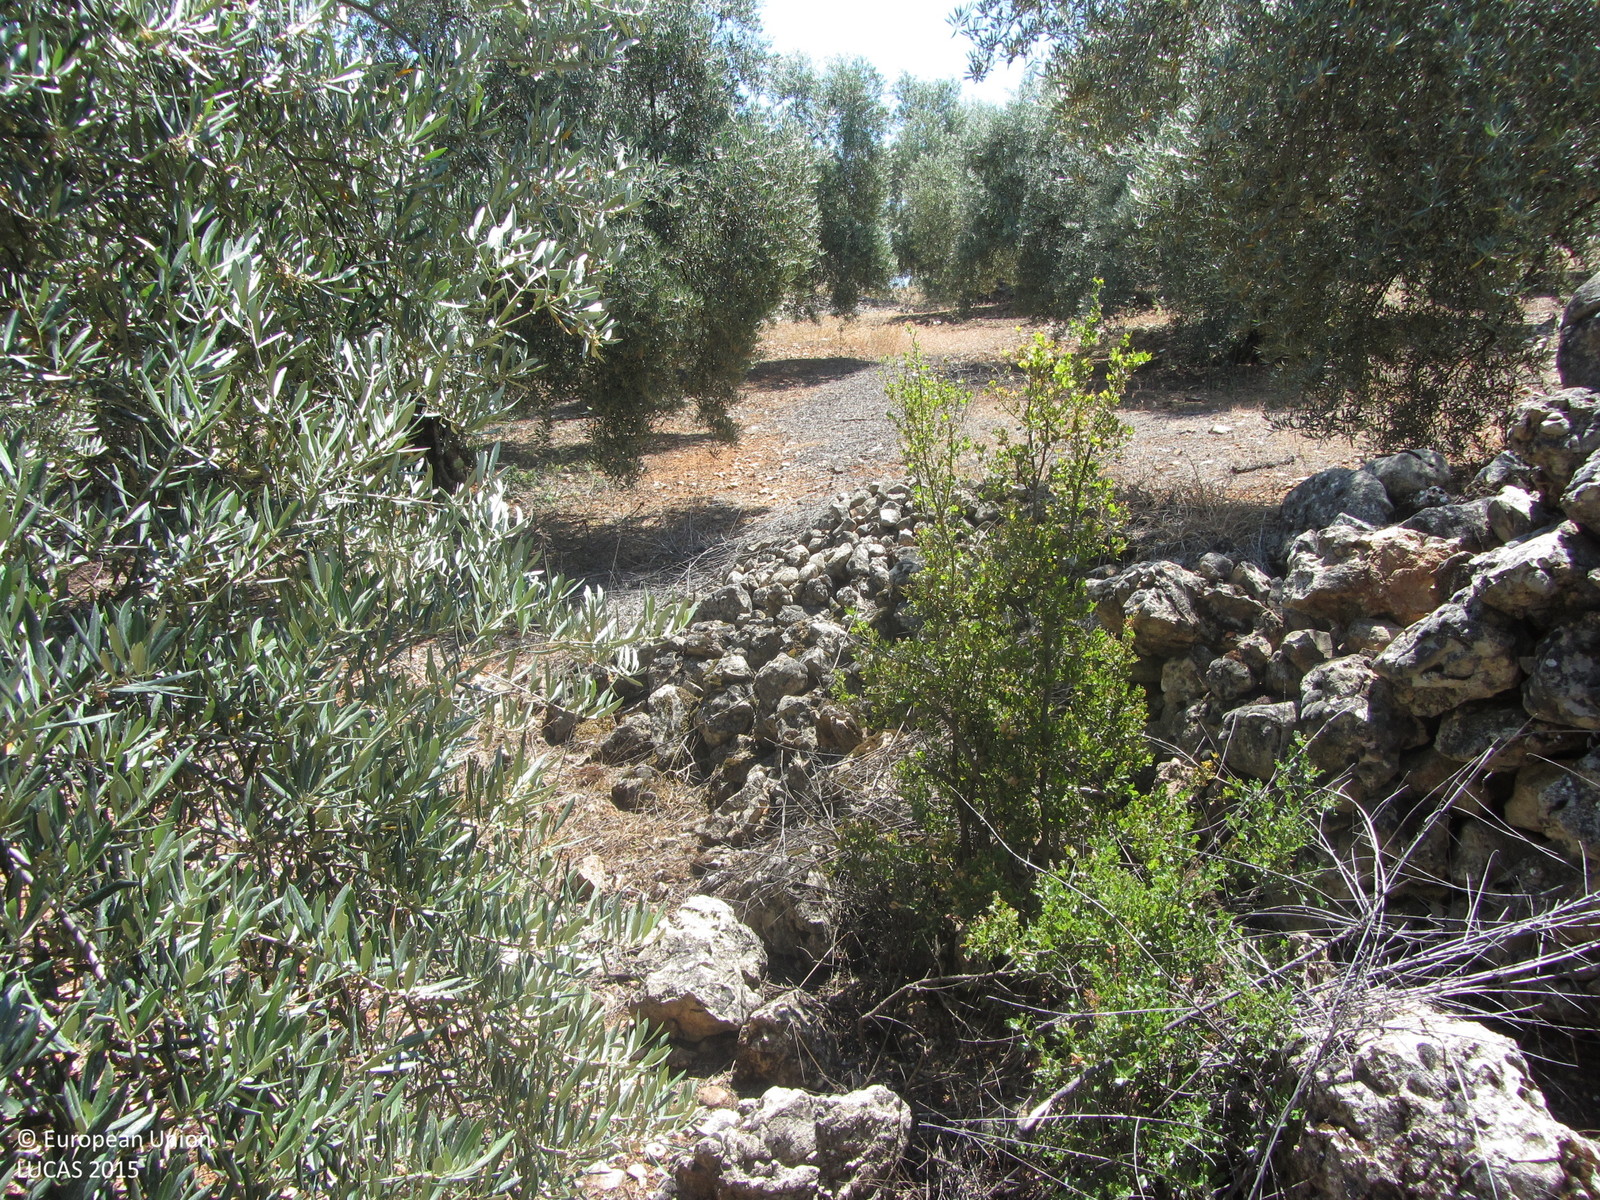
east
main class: Cropland
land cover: Olive groves
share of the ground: 50 - 75 %
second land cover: Other bare soil
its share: > 75 %
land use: Agriculture (excluding fallow land and kitchen gardens)
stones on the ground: < 10 %
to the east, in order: Olive groves; Other bare soil; Dry stone walls; Olive groves; Dry stone walls; Olive groves; Dry stone walls; Olive groves
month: June
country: ES
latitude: 38.2789
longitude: -2.8825
